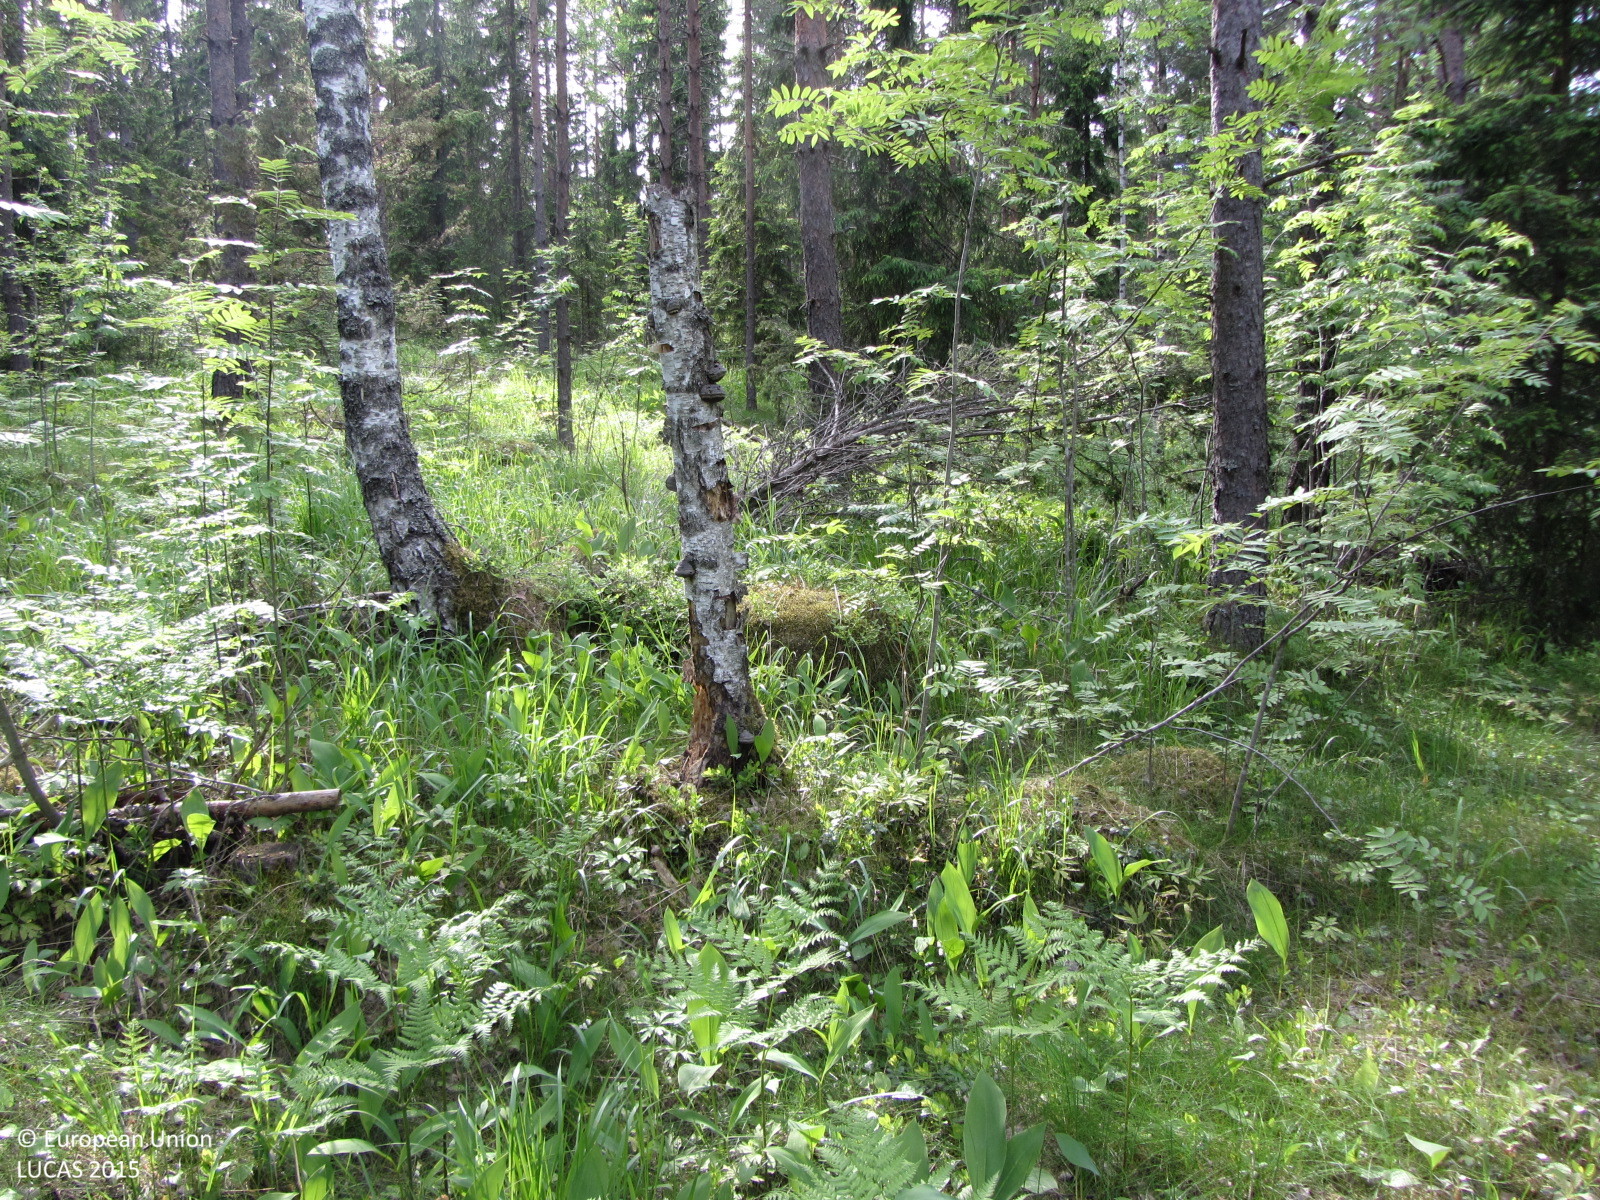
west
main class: Woodland
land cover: Pine dominated mixed woodland
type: boreal forest
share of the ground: > 75 %
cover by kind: coniferous forest trees 45 %, broadleaved forest trees 35 %, herbaceous plants 10 %, shrubs 5 %, lichens and mosses 5 %
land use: Forestry
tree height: > 5 m
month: June
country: FI
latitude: 60.3077
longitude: 24.3110
